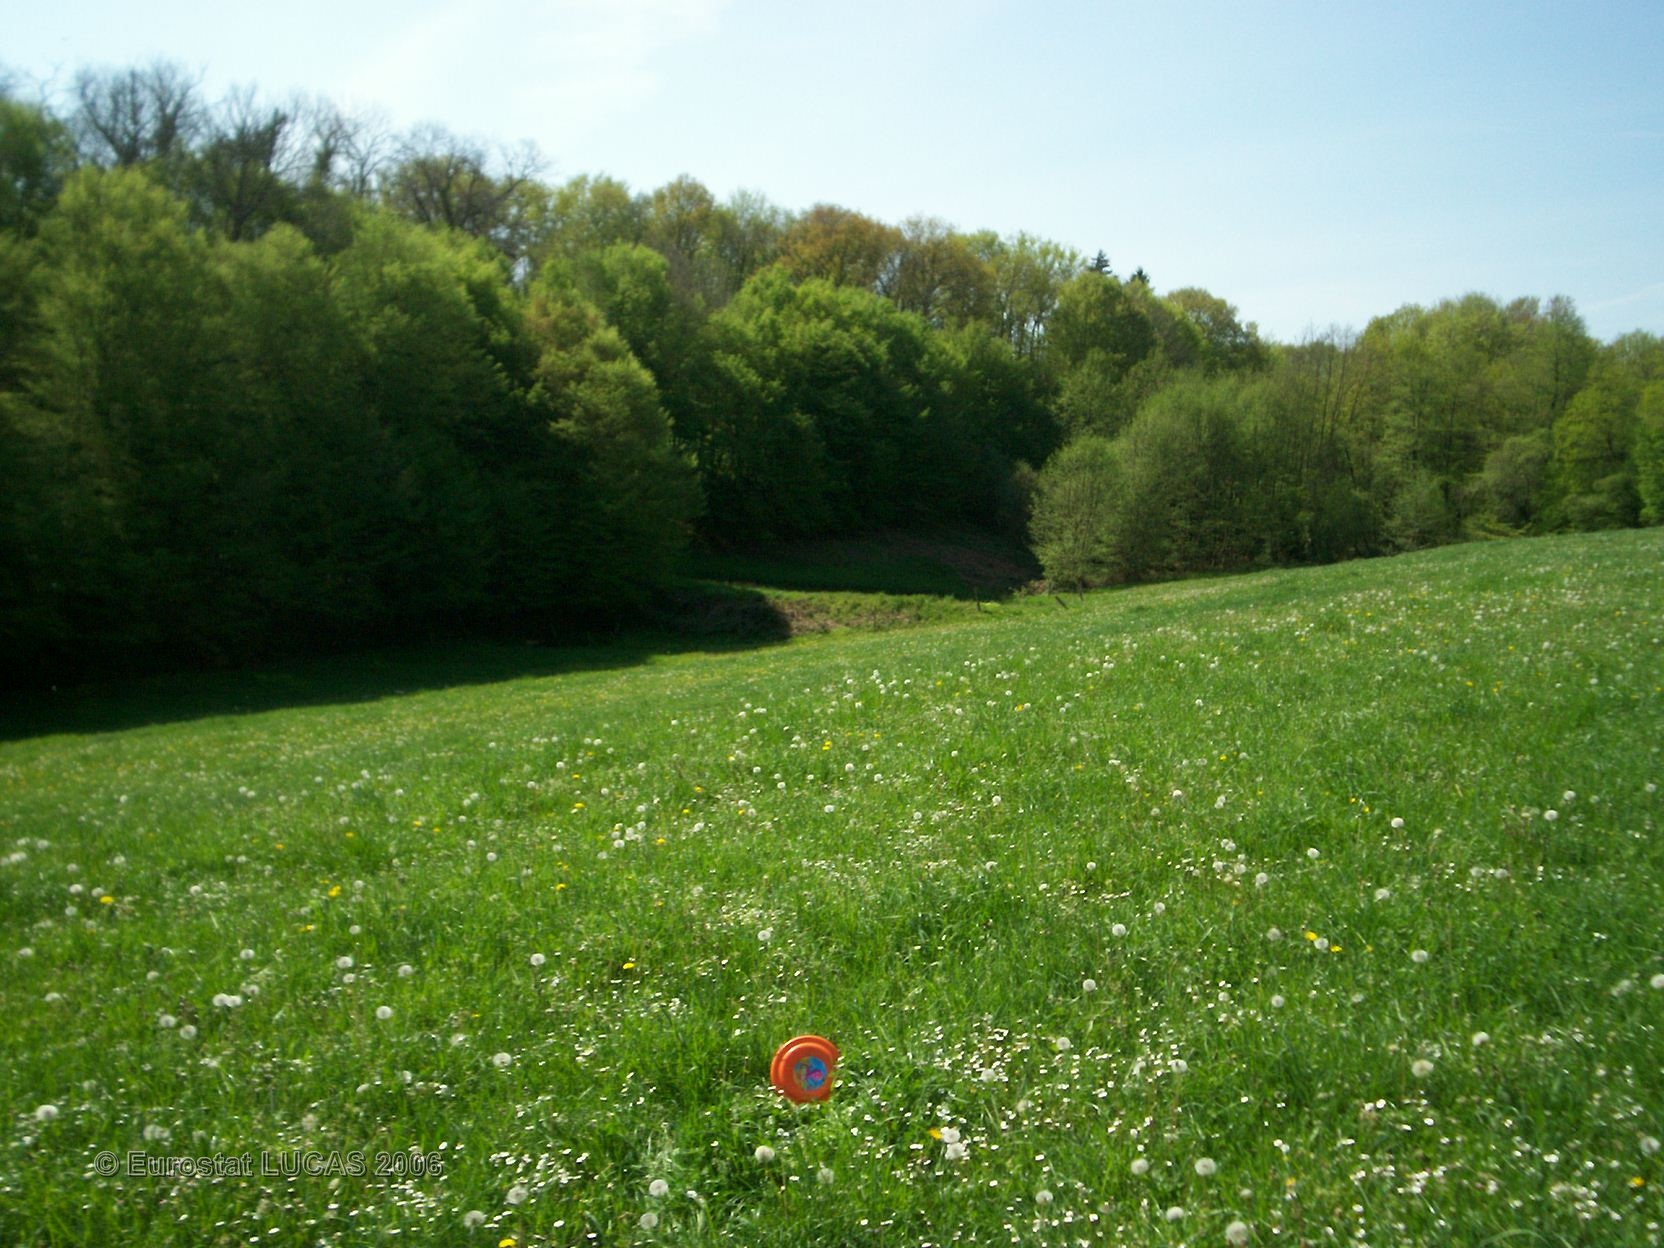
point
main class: Grassland
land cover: Grassland without tree/shrub cover
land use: Agriculture (excluding fallow land and kitchen gardens)
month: May
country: FR
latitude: 46.3848
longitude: 1.6301
